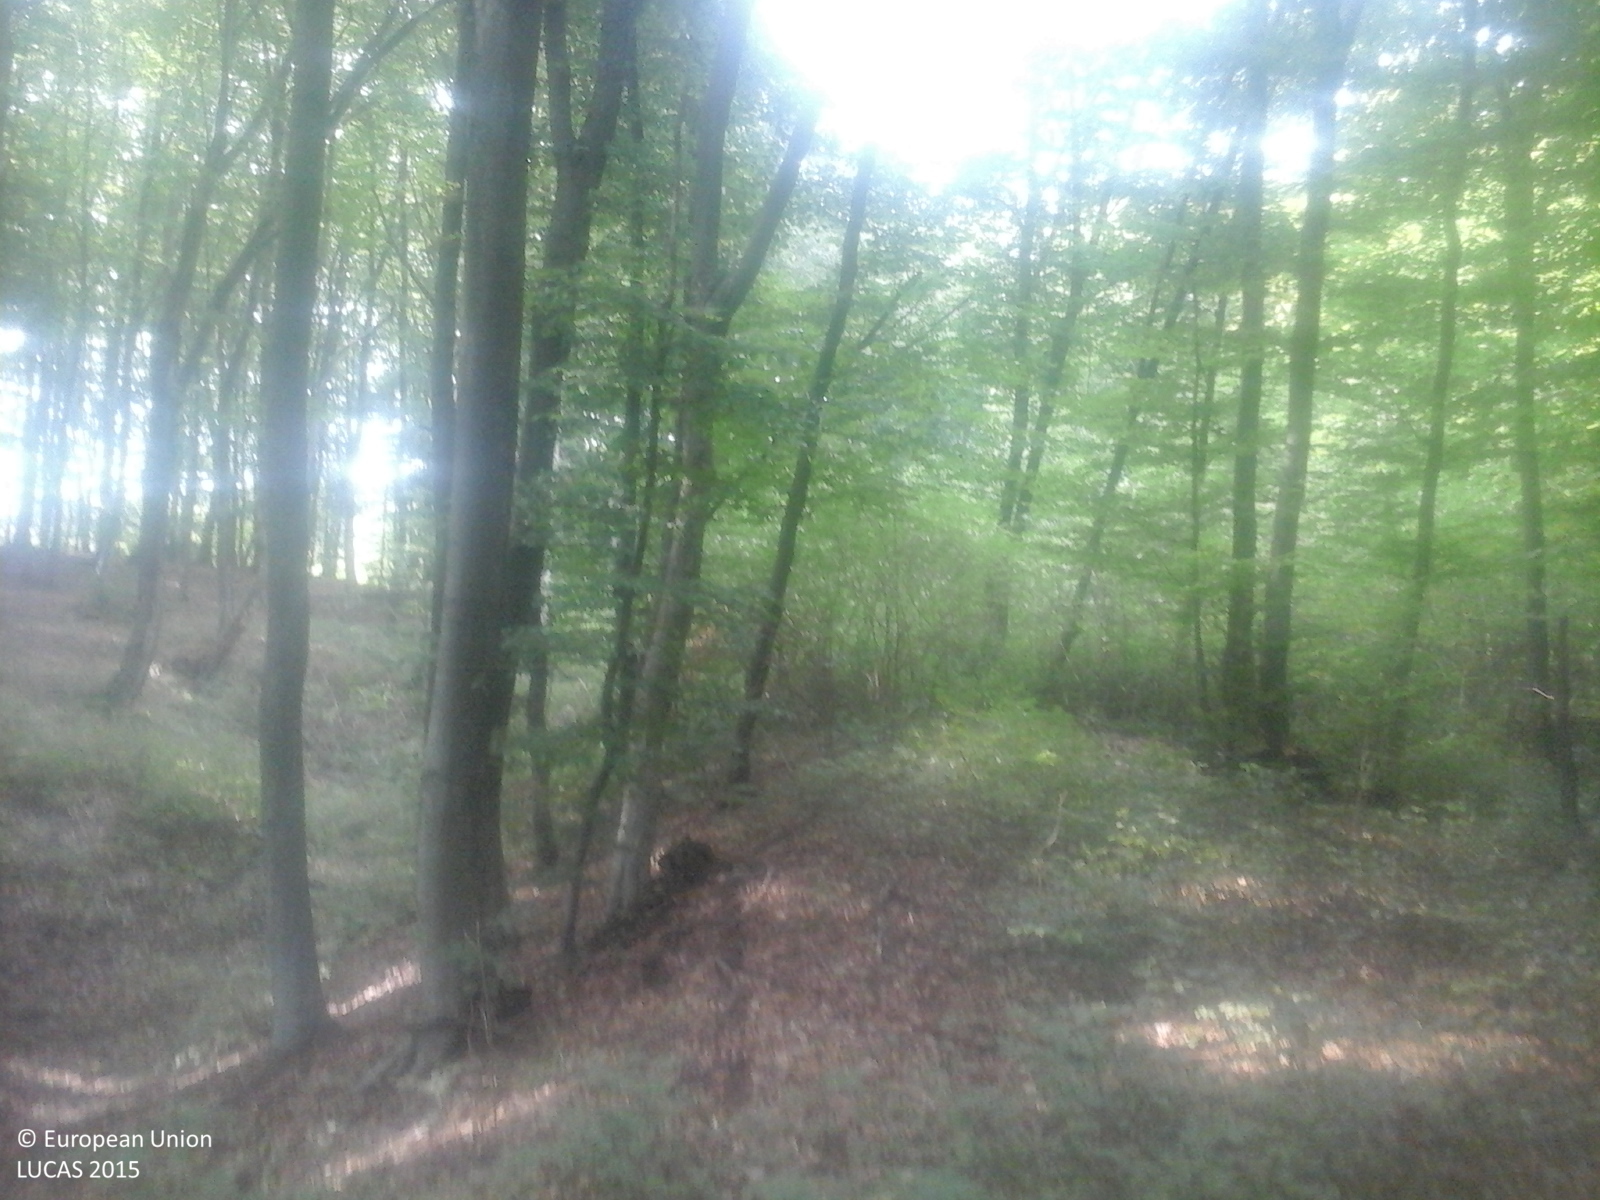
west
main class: Woodland
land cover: Broadleaved woodland
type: beech forest
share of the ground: > 75 %
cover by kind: broadleaved forest trees 100 %
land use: Forestry
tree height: > 5 m
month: September
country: RO
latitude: 47.1452
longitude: 23.1066
